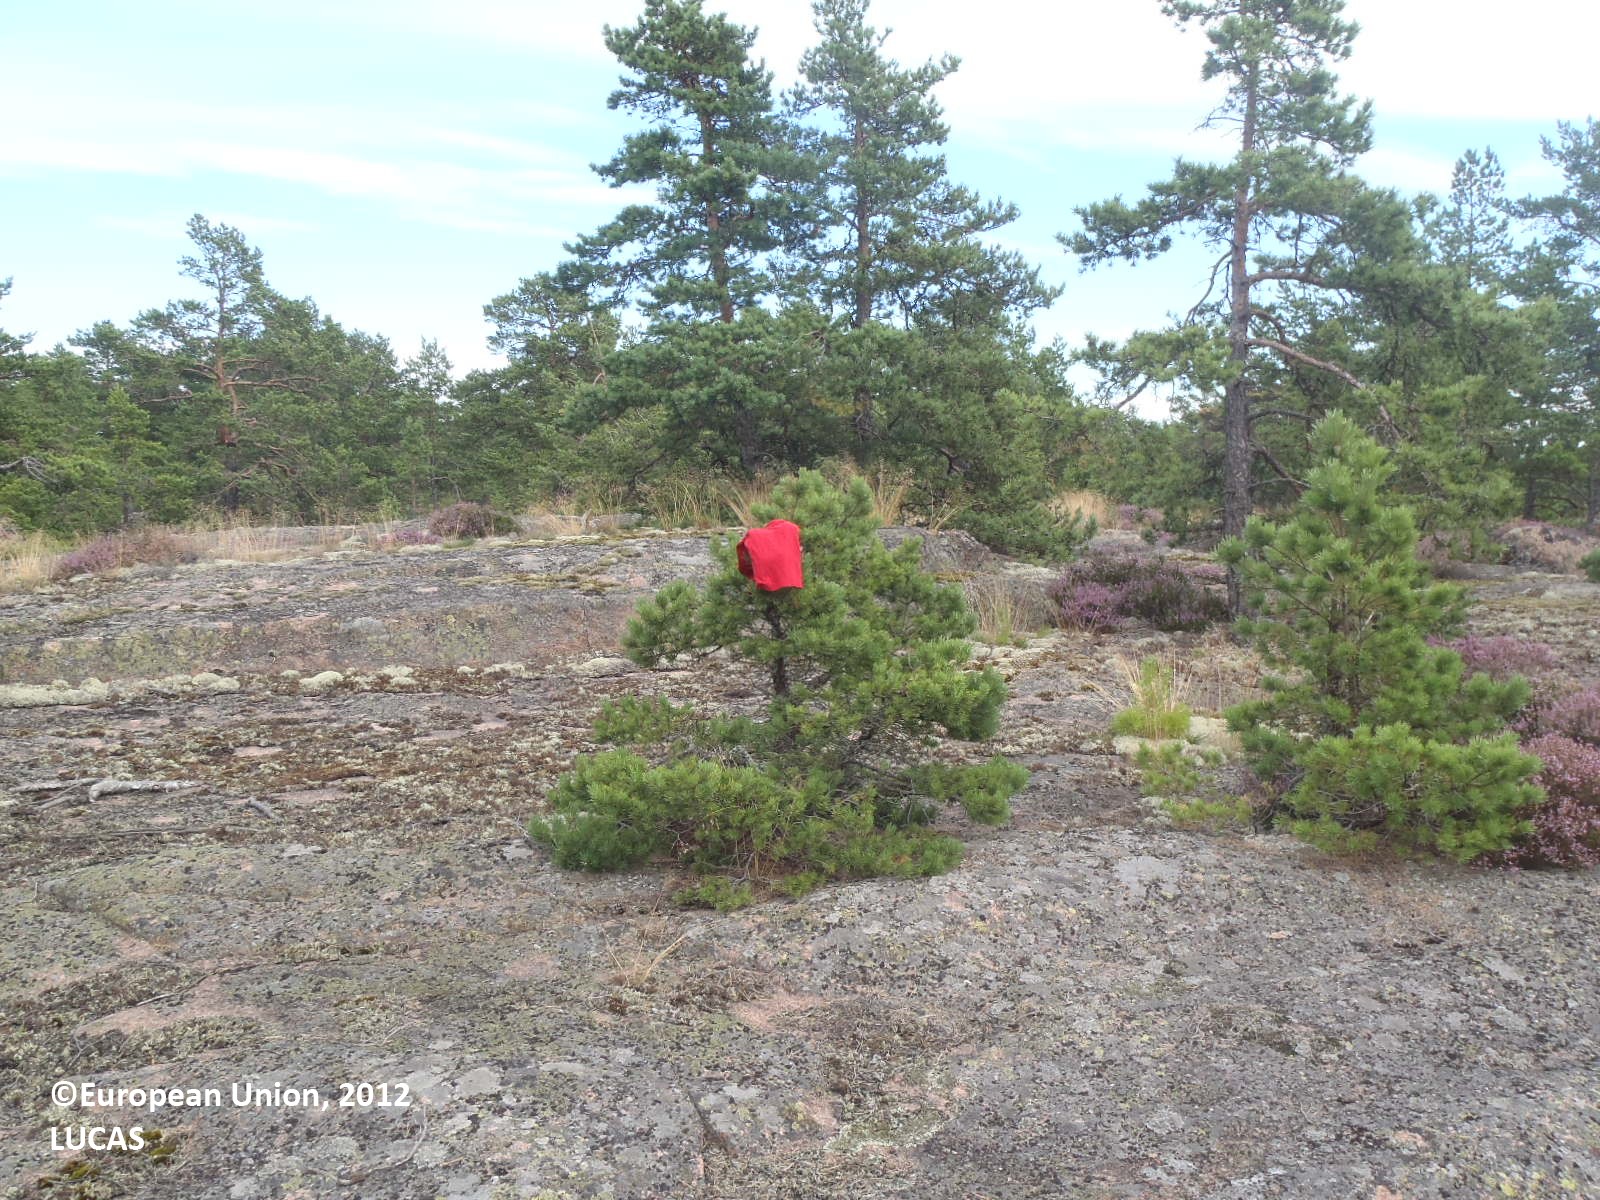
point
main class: Woodland
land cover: Pine dominated coniferous woodland
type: boreal forest
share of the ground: 10 - 25 %
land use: Semi-natural and natural areas not in use
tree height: > 5 m
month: August
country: FI
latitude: 60.2321
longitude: 20.3928
